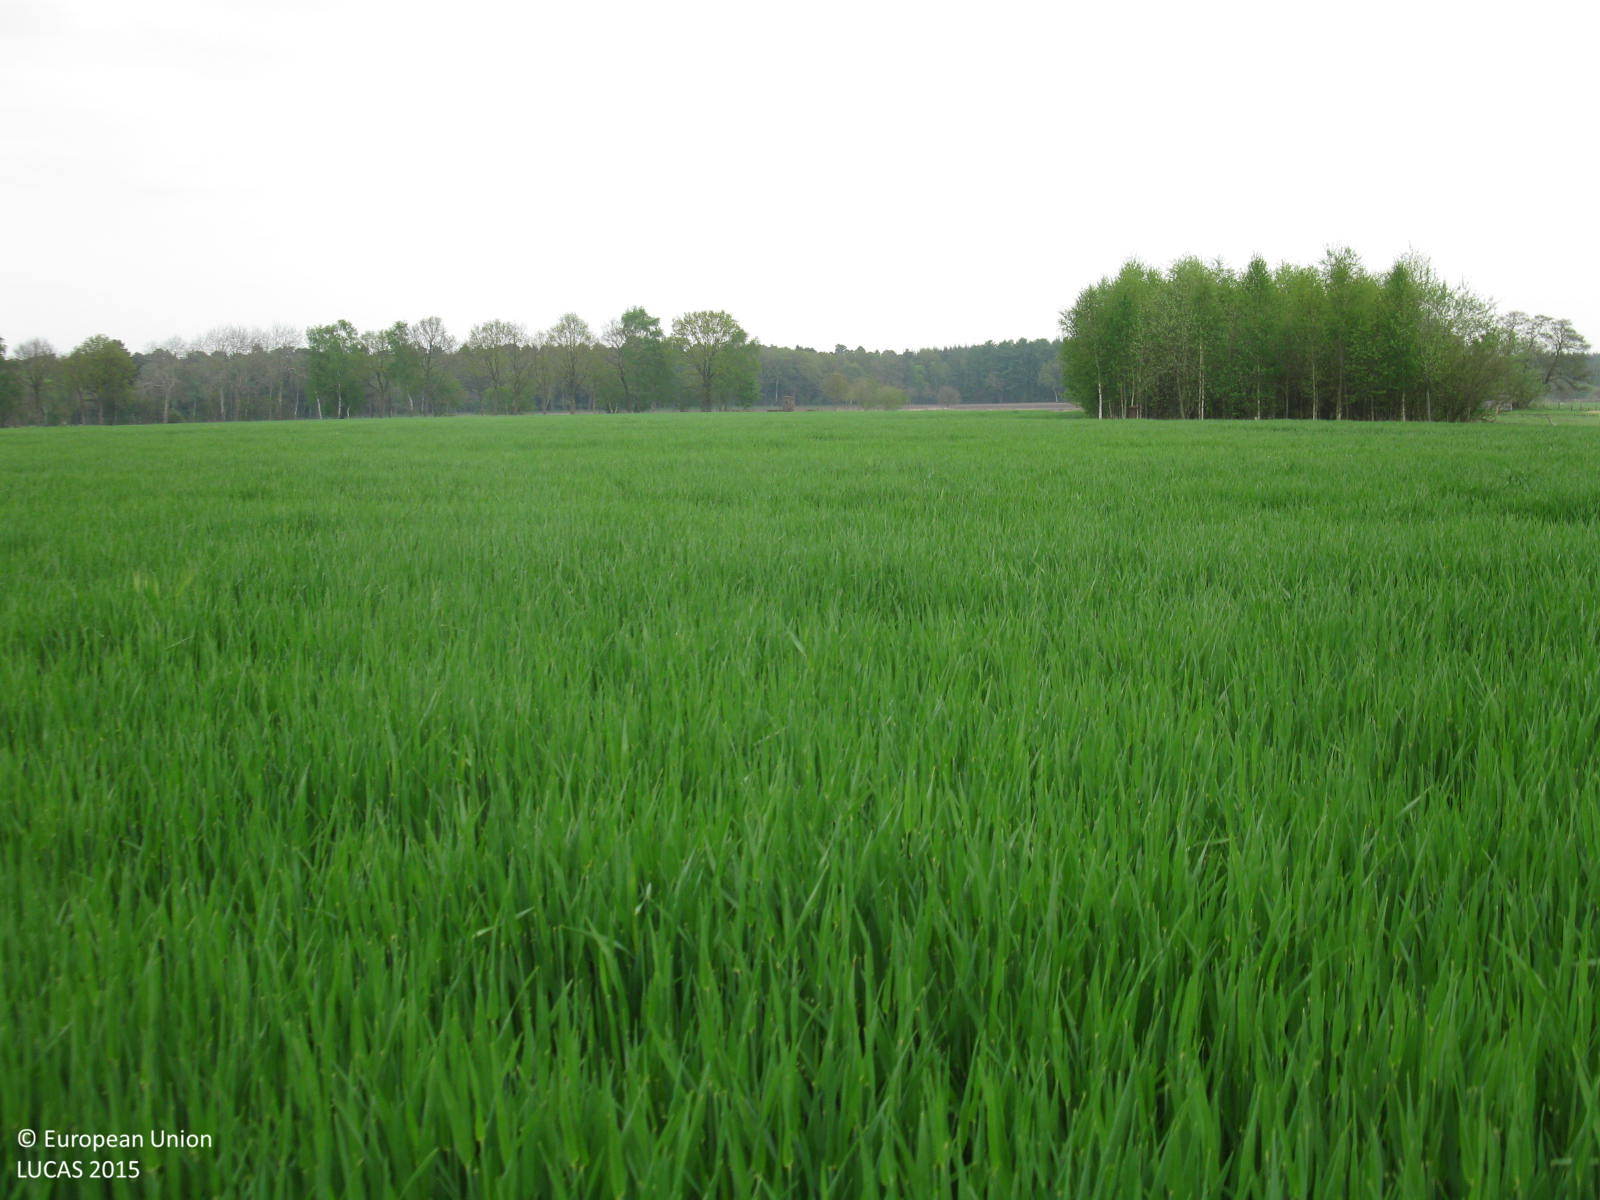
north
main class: Cropland
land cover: Barley
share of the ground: > 75 %
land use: Agriculture (excluding fallow land and kitchen gardens)
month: May
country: DE
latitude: 52.8809
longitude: 7.9351
